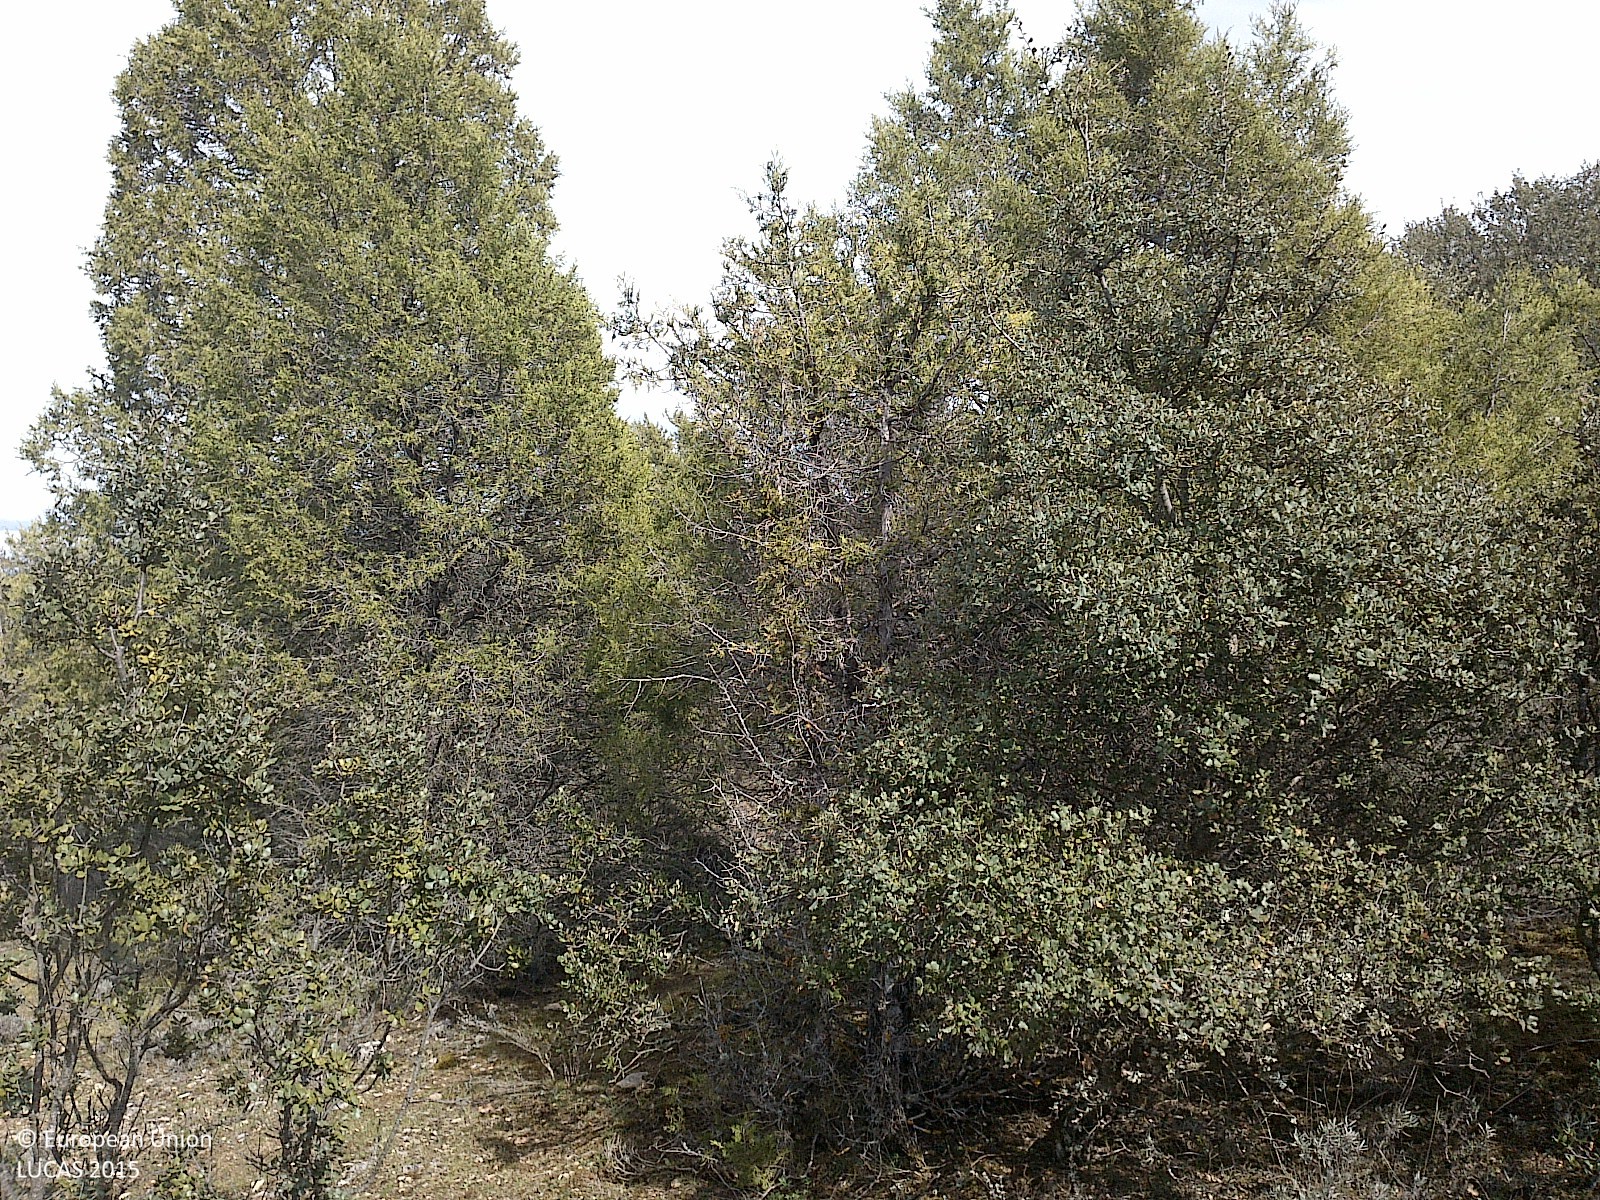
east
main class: Woodland
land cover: Other mixed woodland
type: coniferous forest of the mediterranean region
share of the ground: 50 - 75 %
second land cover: Spontaneously vegetated surfaces
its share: 50 - 75 %
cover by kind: coniferous forest trees 45 %, herbaceous plants 30 %, broadleaved forest trees 20 %, shrubs 5 %
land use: Forestry
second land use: Agriculture (excluding fallow land and kitchen gardens)
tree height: < 5 m
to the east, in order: Other mixed woodland; Spontaneously vegetated surfaces; Broadleaved woodland; Tracks; Other mixed woodland
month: April
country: ES
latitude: 41.9544
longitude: -3.5784
